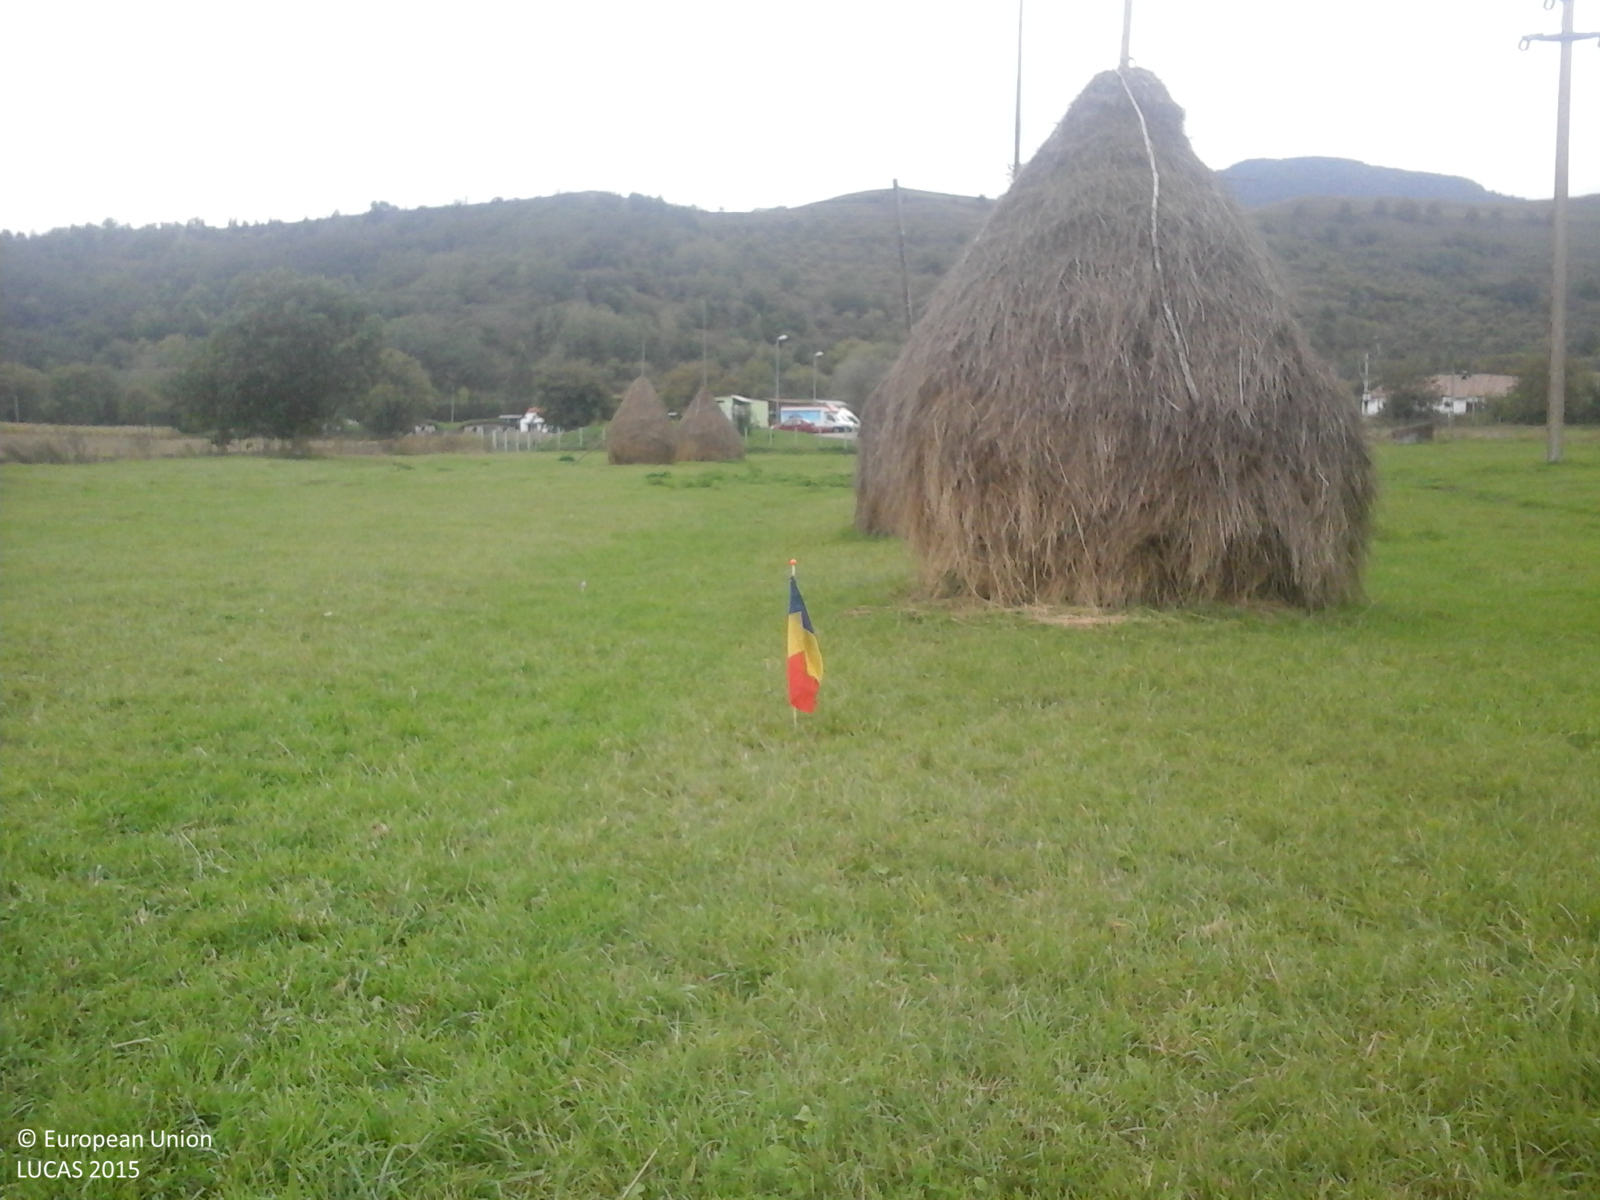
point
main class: Grassland
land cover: Grassland without tree/shrub cover
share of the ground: > 75 %
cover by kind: herbaceous plants 100 %
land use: Agriculture (excluding fallow land and kitchen gardens)
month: October
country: RO
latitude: 46.4315
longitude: 23.5639
